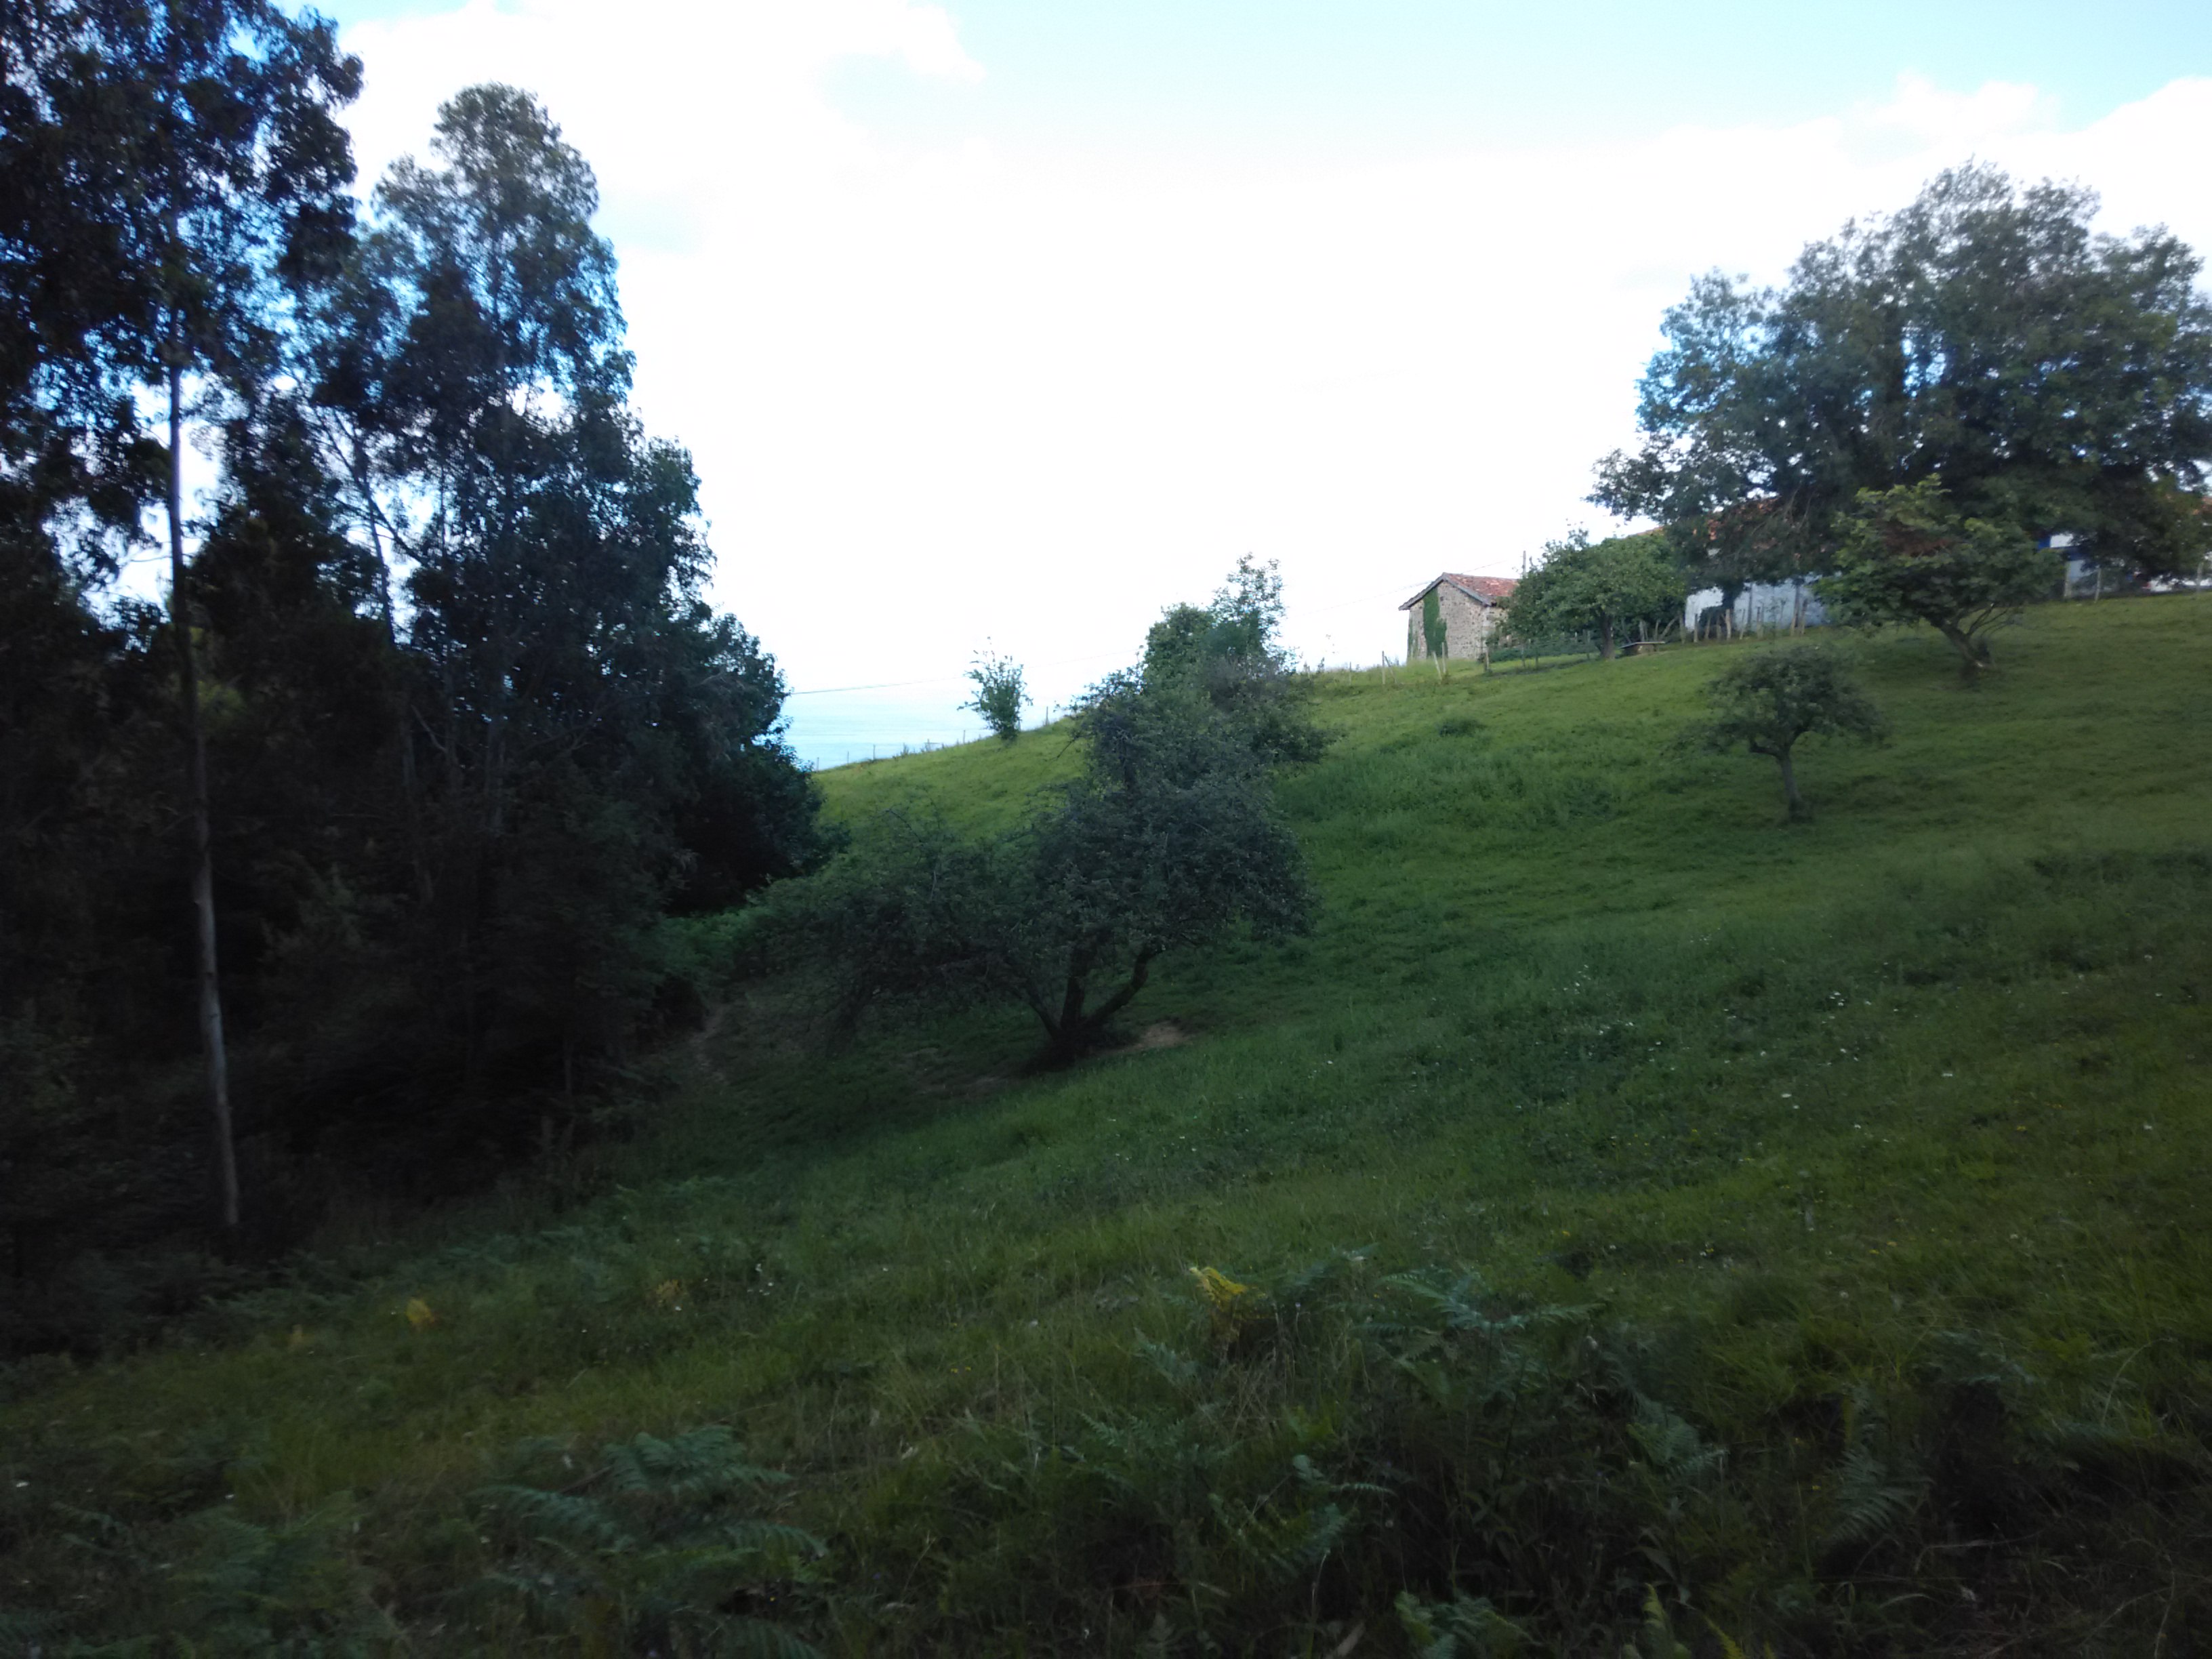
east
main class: Woodland
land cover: Broadleaved woodland
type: exotic forest
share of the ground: > 75 %
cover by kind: broadleaved forest trees 90 %, shrubs 10 %
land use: Forestry
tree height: > 5 m
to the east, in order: Broadleaved woodland; Fences; Grassland with sparse tree/shrub cover; Fences; Grassland without tree/shrub cover; Electric lines; Grassland without tree/shrub cover; Fences; Grassland without tree/shrub cover; Fences; Grassland without tree/shrub cover
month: June
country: ES
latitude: 43.3392
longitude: -2.4745
